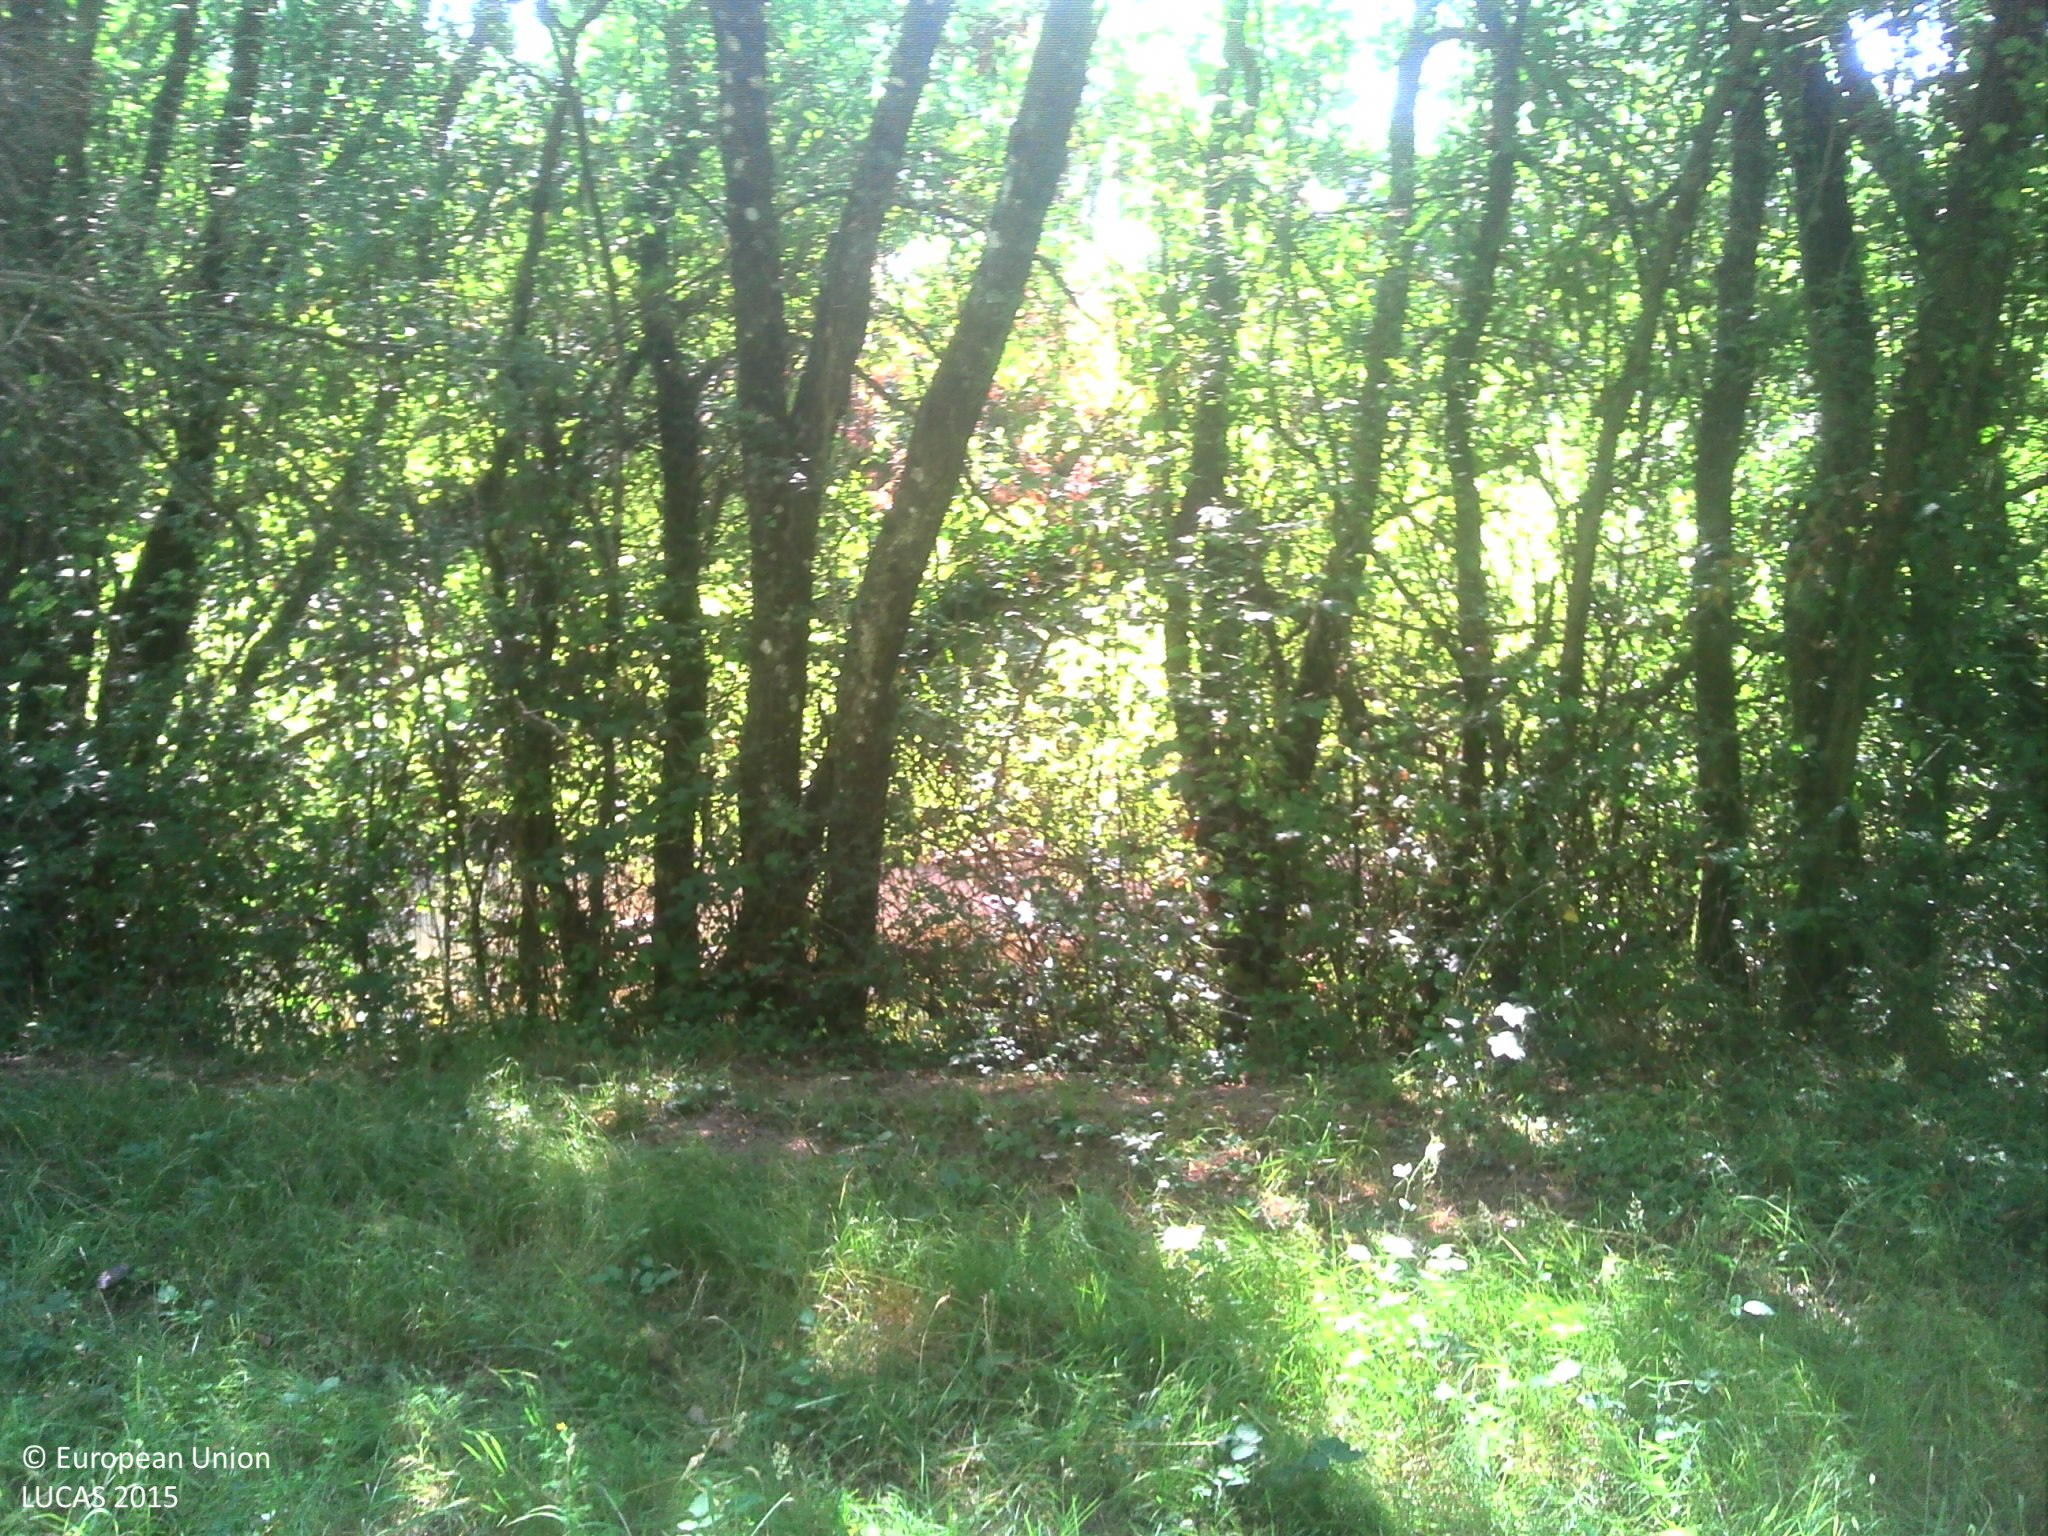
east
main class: Woodland
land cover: Broadleaved woodland
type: mesophytic deciduous forest
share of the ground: > 75 %
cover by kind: herbaceous plants 50 %, broadleaved forest trees 40 %, unconsolidated bare surface 10 %
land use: Forestry
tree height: > 5 m
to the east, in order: Broadleaved woodland; Grassland without tree/shrub cover; Lines of trees; Inland fresh water bodies; Broadleaved woodland; Maize; Spontaneously vegetated surfaces; Tracks; Managed hedges; Rape and turnip rape
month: July
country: FR
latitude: 47.9541
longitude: 0.8878
